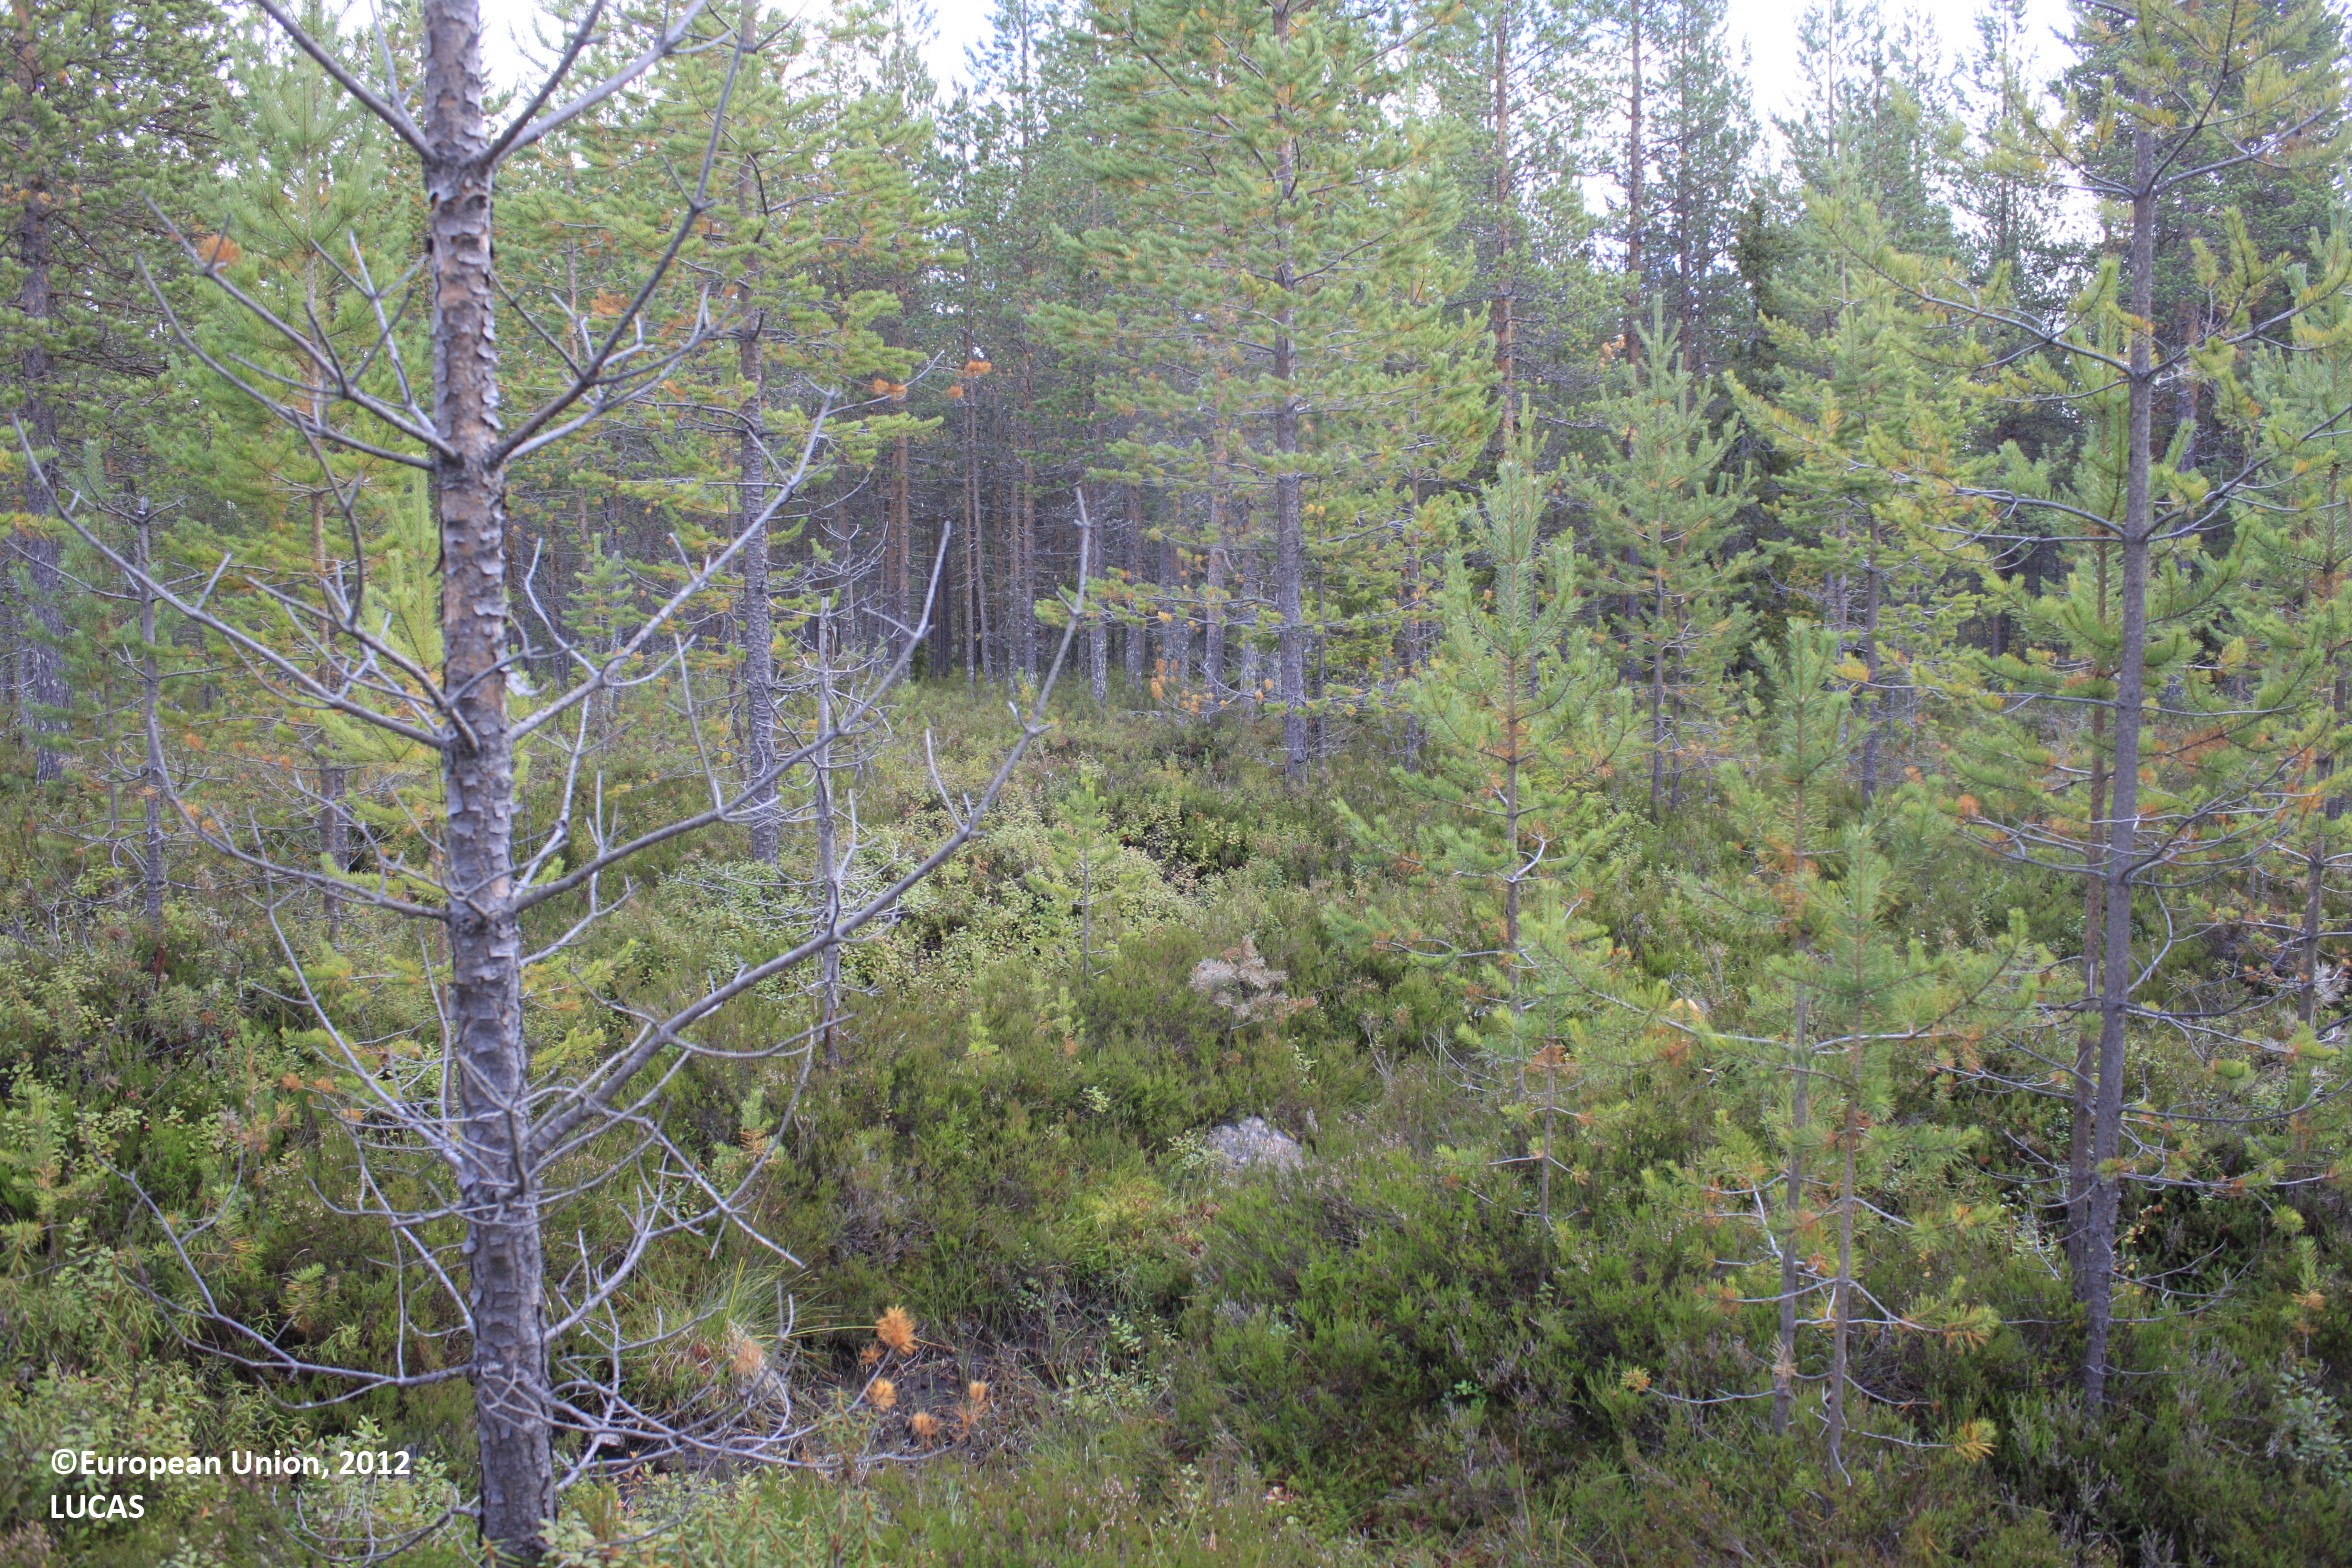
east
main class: Woodland
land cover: Pine dominated coniferous woodland
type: boreal forest
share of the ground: 25 - 50 %
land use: Forestry
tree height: > 5 m
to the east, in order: Pine dominated coniferous woodland; Ditches and canals; Pine dominated coniferous woodland; Ditches and canals; Pine dominated coniferous woodland; Ditches and canals; Pine dominated coniferous woodland; Ditches and canals; Pine dominated coniferous woodland; Ditches and canals; Pine dominated coniferous woodland
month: September
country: FI
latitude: 65.6935
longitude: 27.0749
